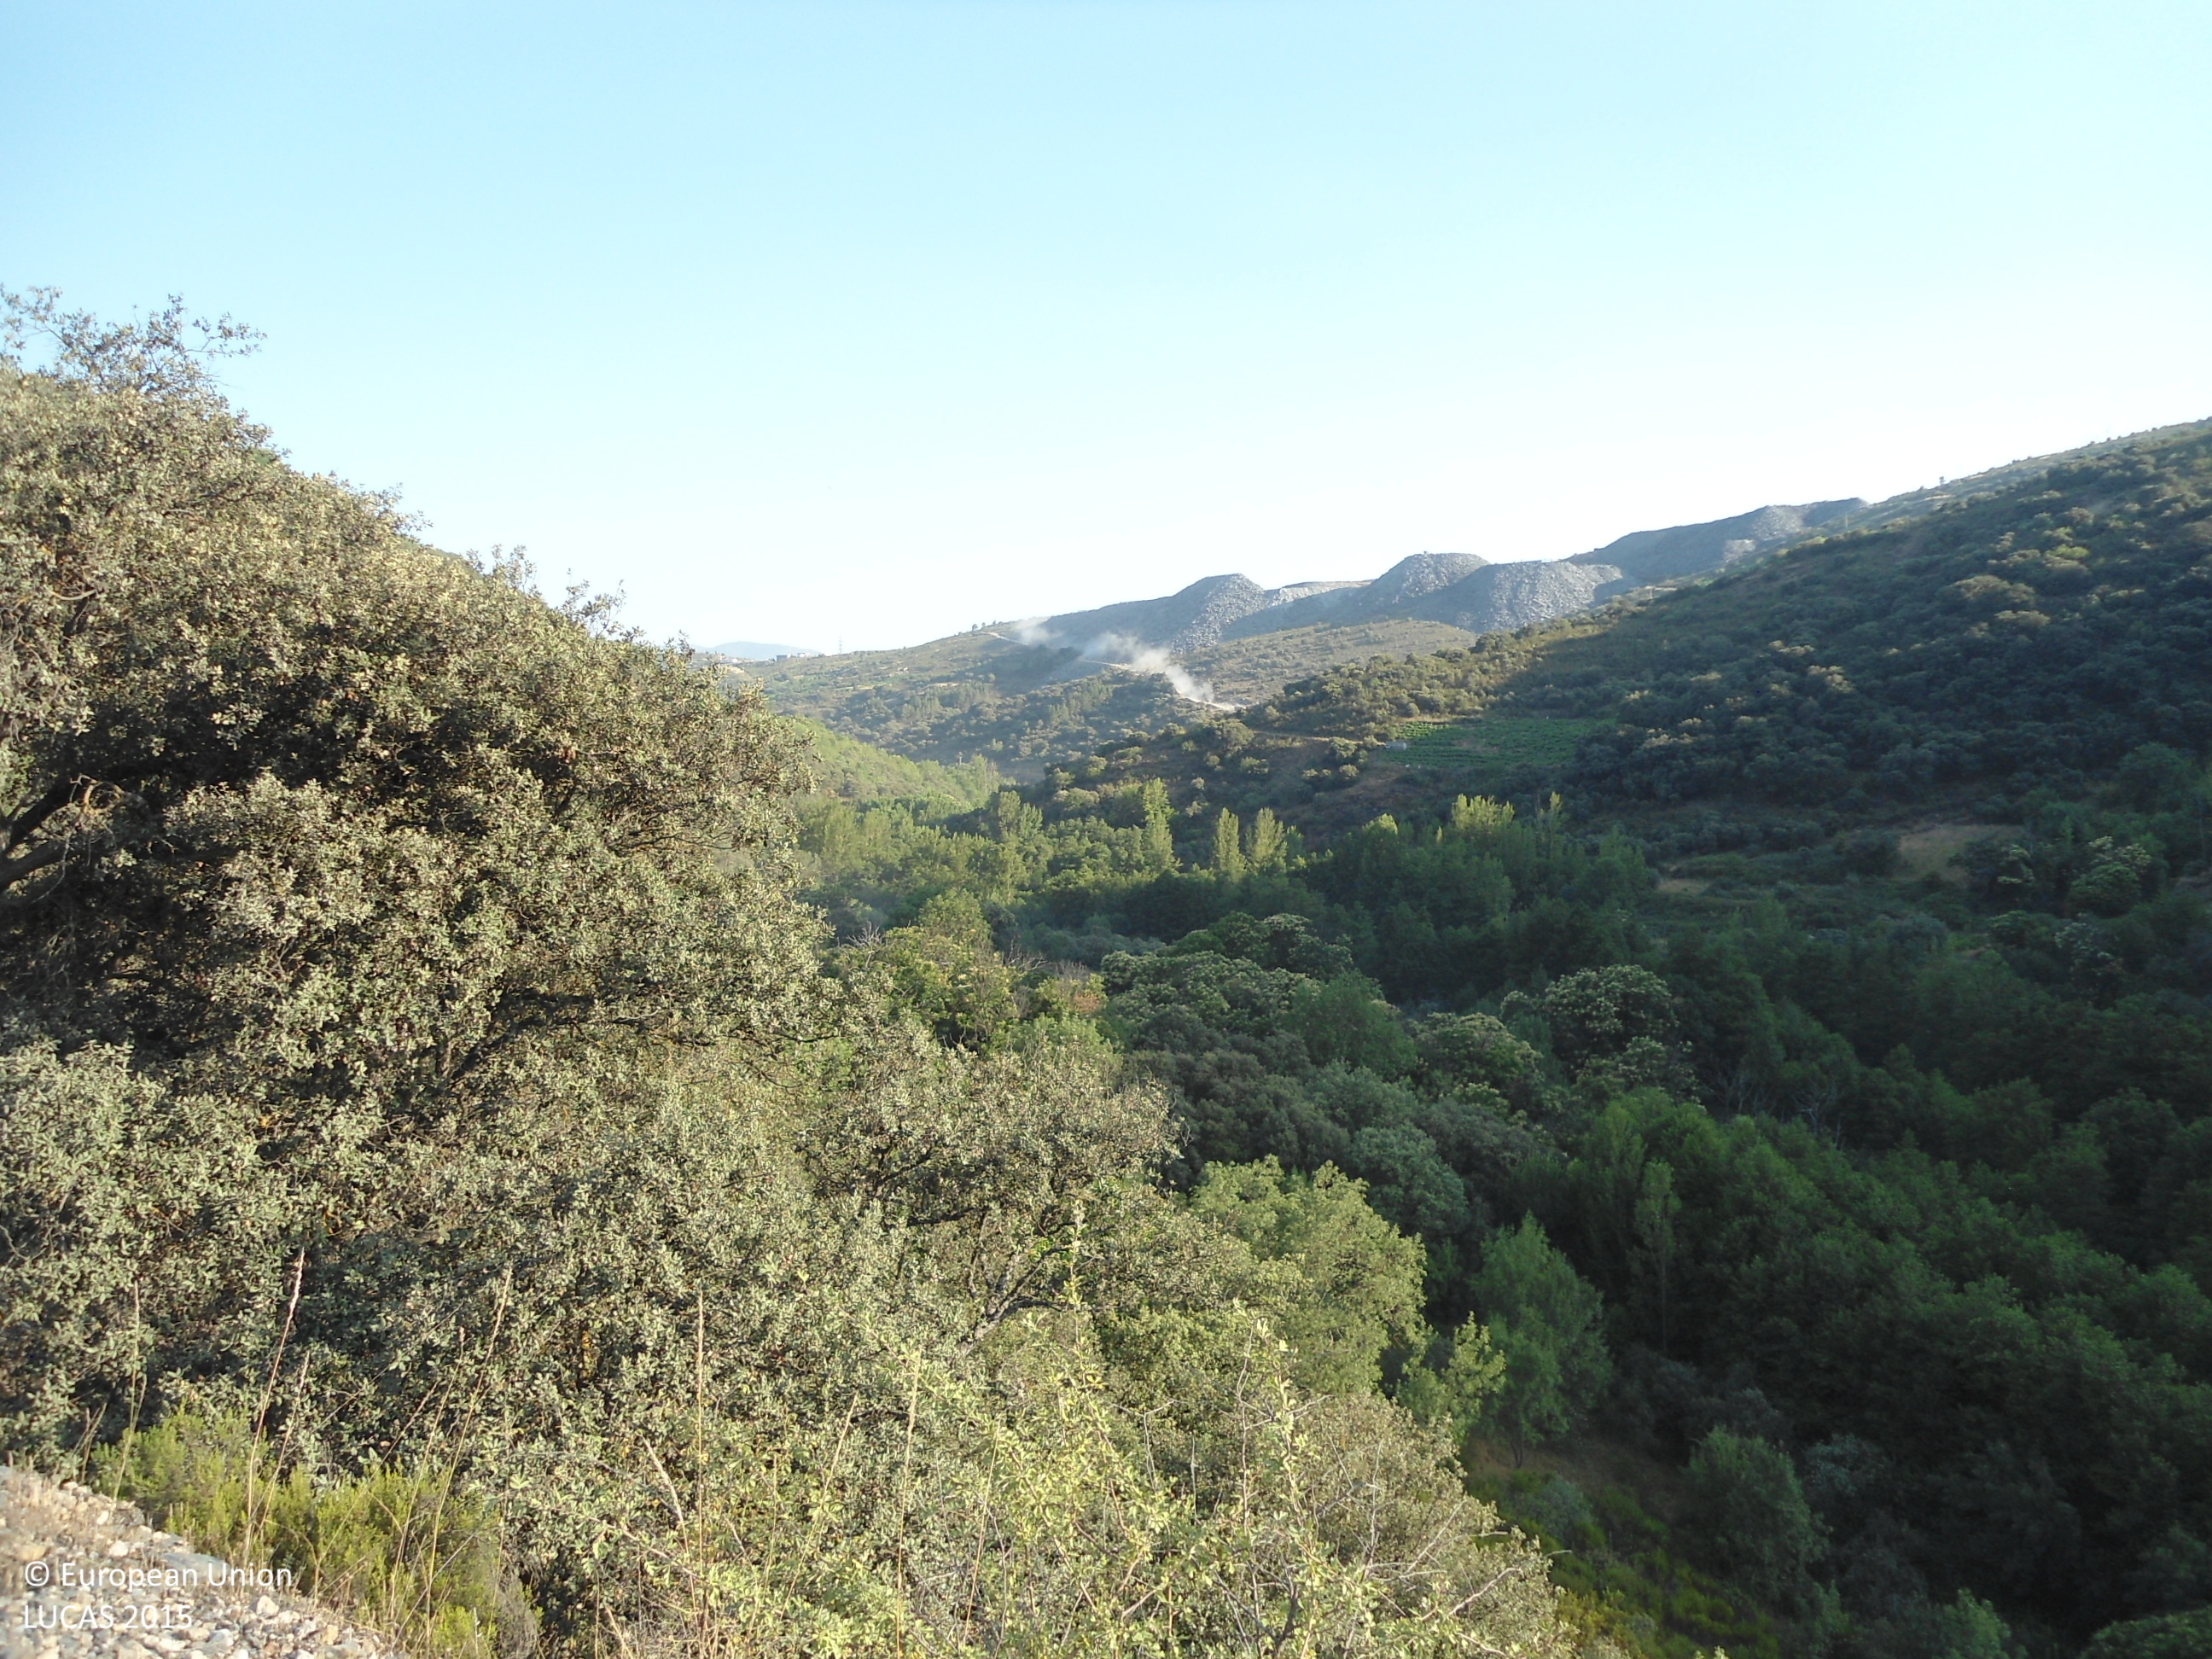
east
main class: Shrubland
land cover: Shrubland with sparse tree cover
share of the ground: > 75 %
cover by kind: shrubs 95 %, broadleaved forest trees 5 %
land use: Semi-natural and natural areas not in use
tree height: > 5 m
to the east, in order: Shrubland with sparse tree cover; Rocks and stones
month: June
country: ES
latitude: 42.3724
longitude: -6.8454
